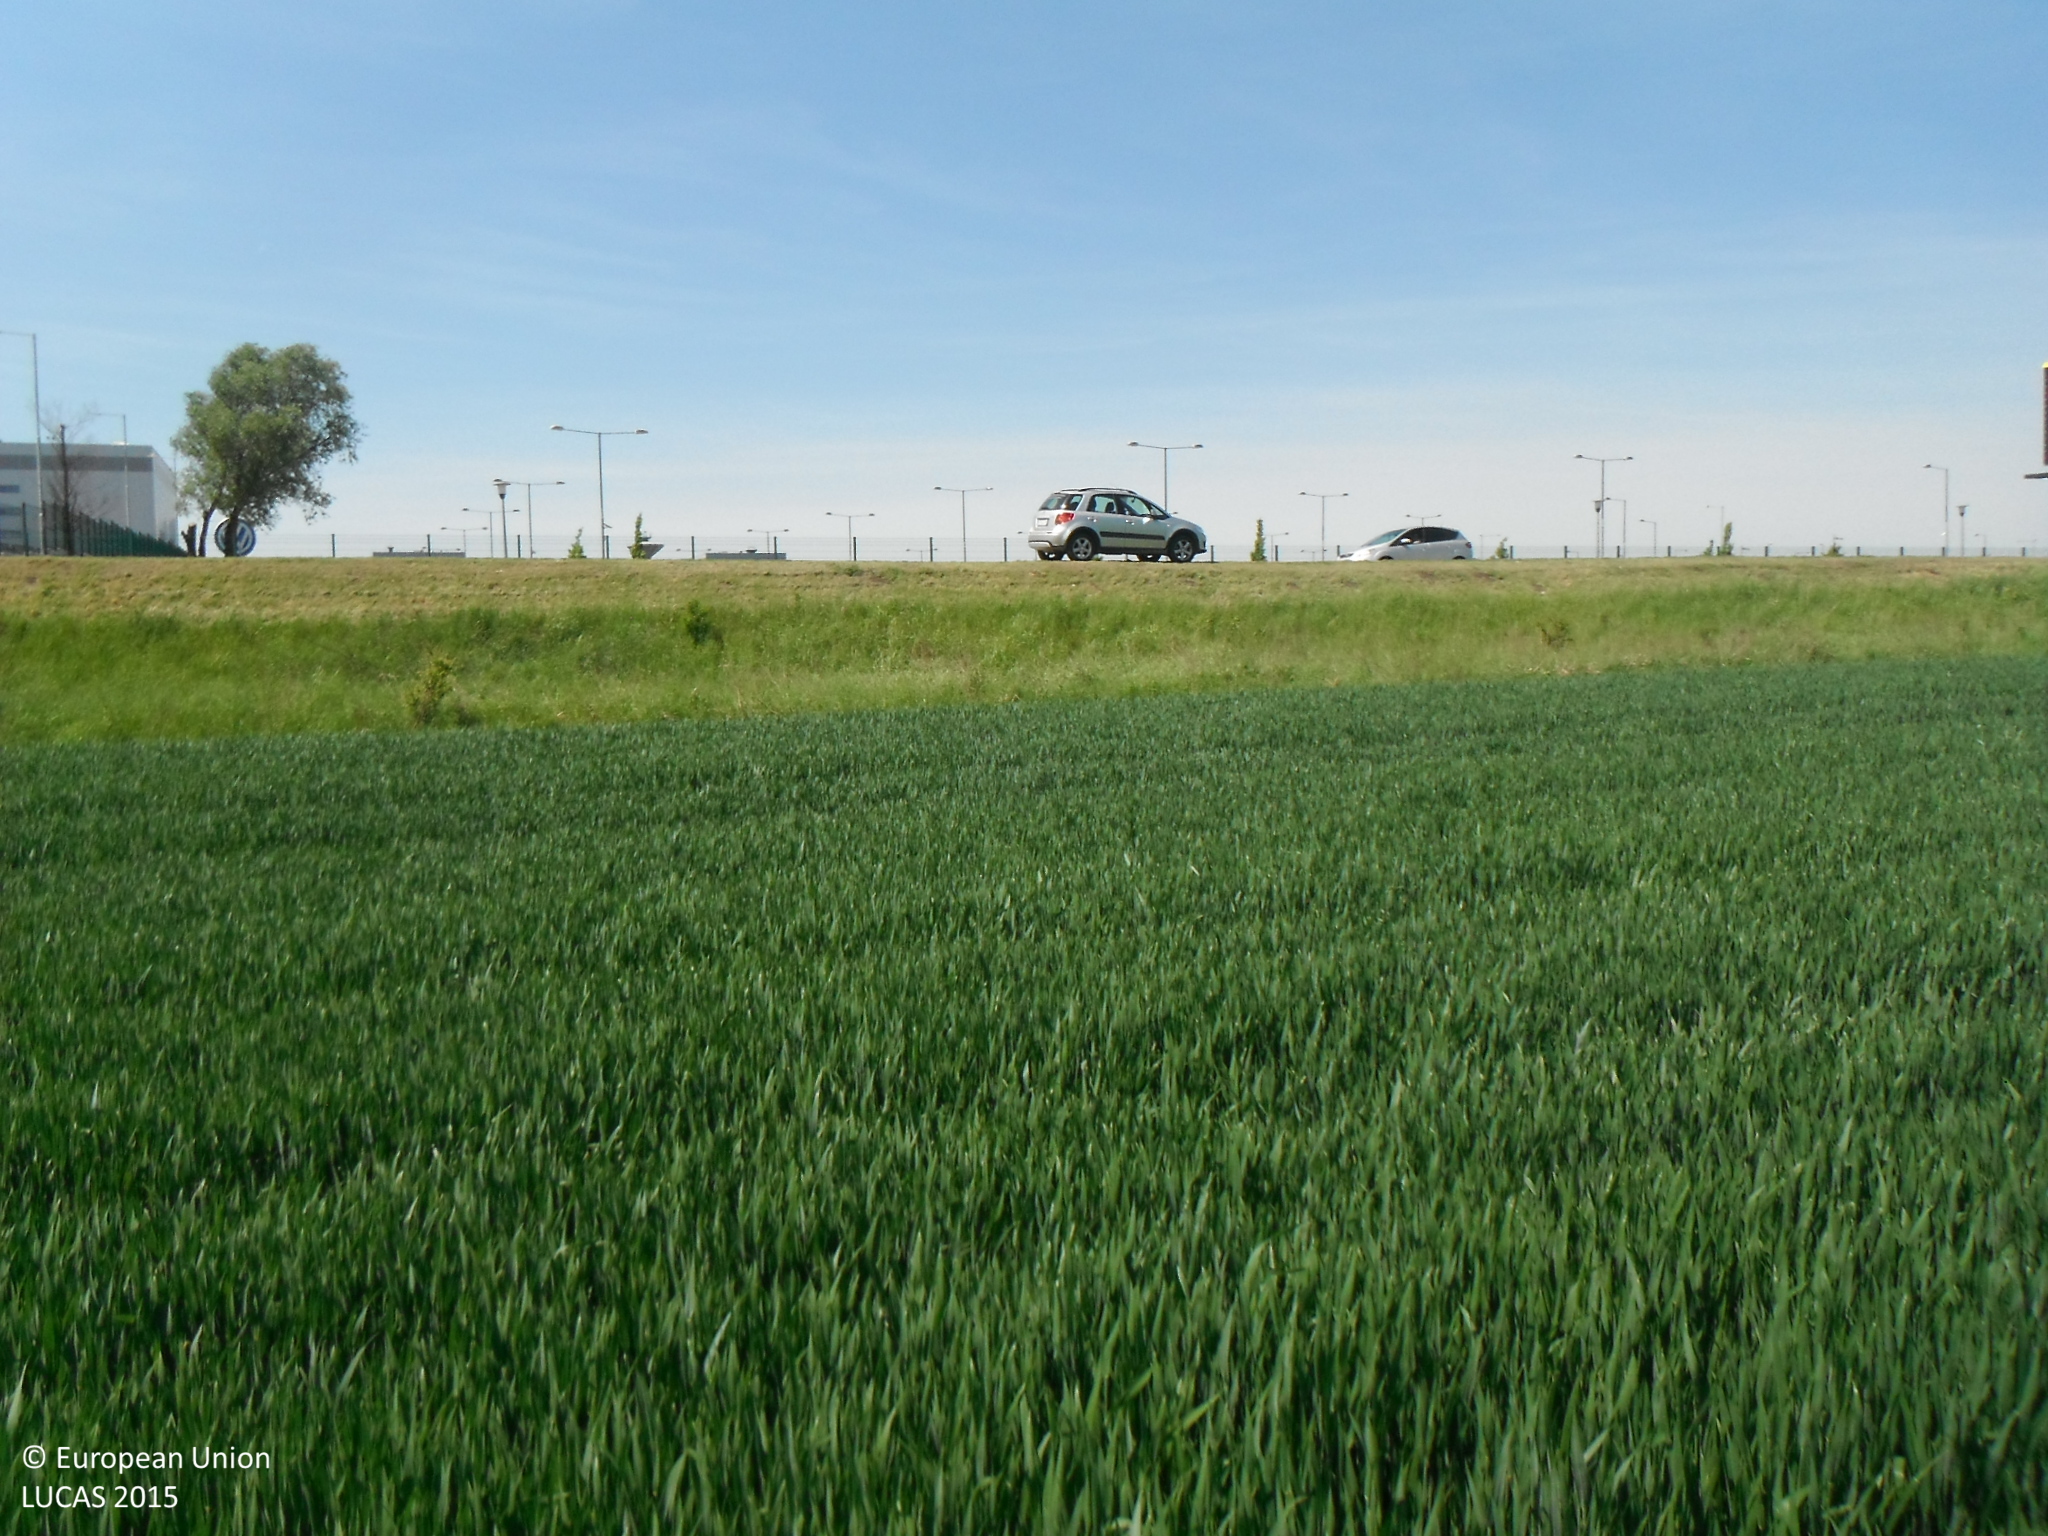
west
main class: Cropland
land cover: Common wheat
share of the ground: > 75 %
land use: Agriculture (excluding fallow land and kitchen gardens)
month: May
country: SK
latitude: 48.2360
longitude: 16.9954
